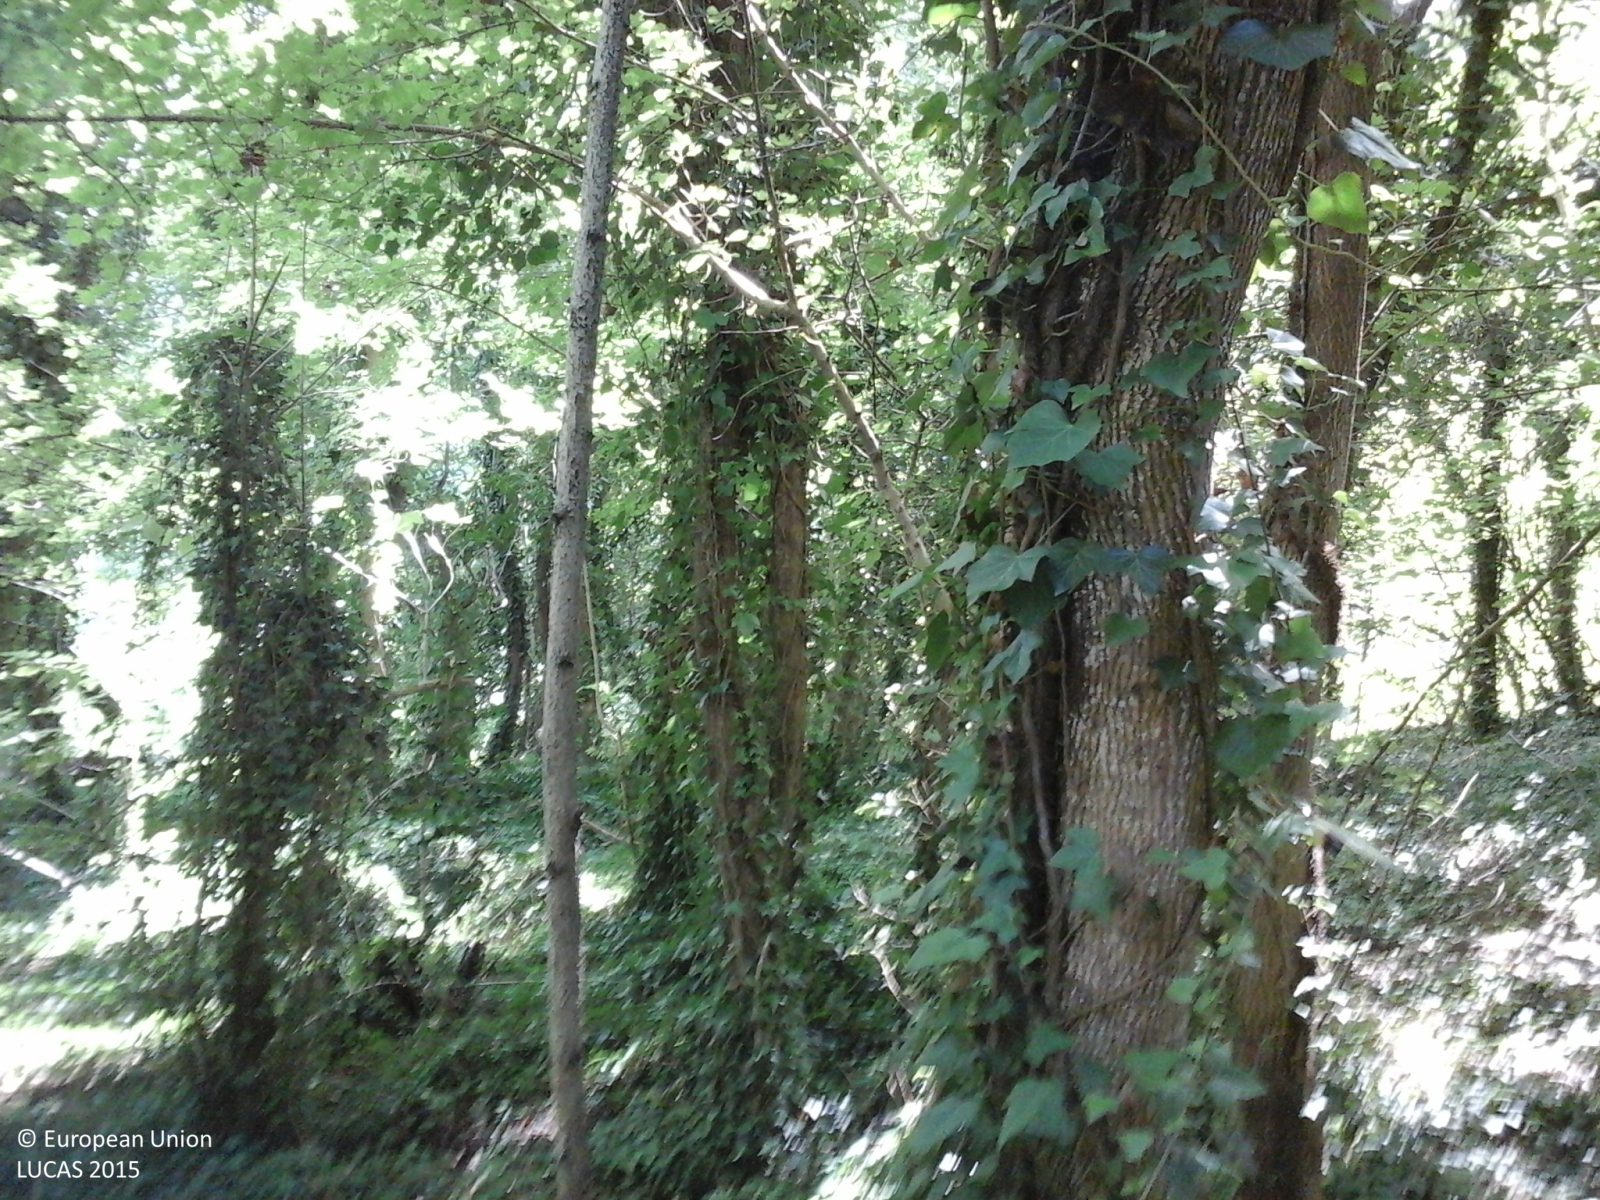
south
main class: Woodland
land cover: Broadleaved woodland
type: thermophilous deciduous forest
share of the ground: > 75 %
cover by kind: broadleaved forest trees 100 %
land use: Forestry
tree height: > 5 m
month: August
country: IT
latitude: 43.0654
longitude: 13.4413
